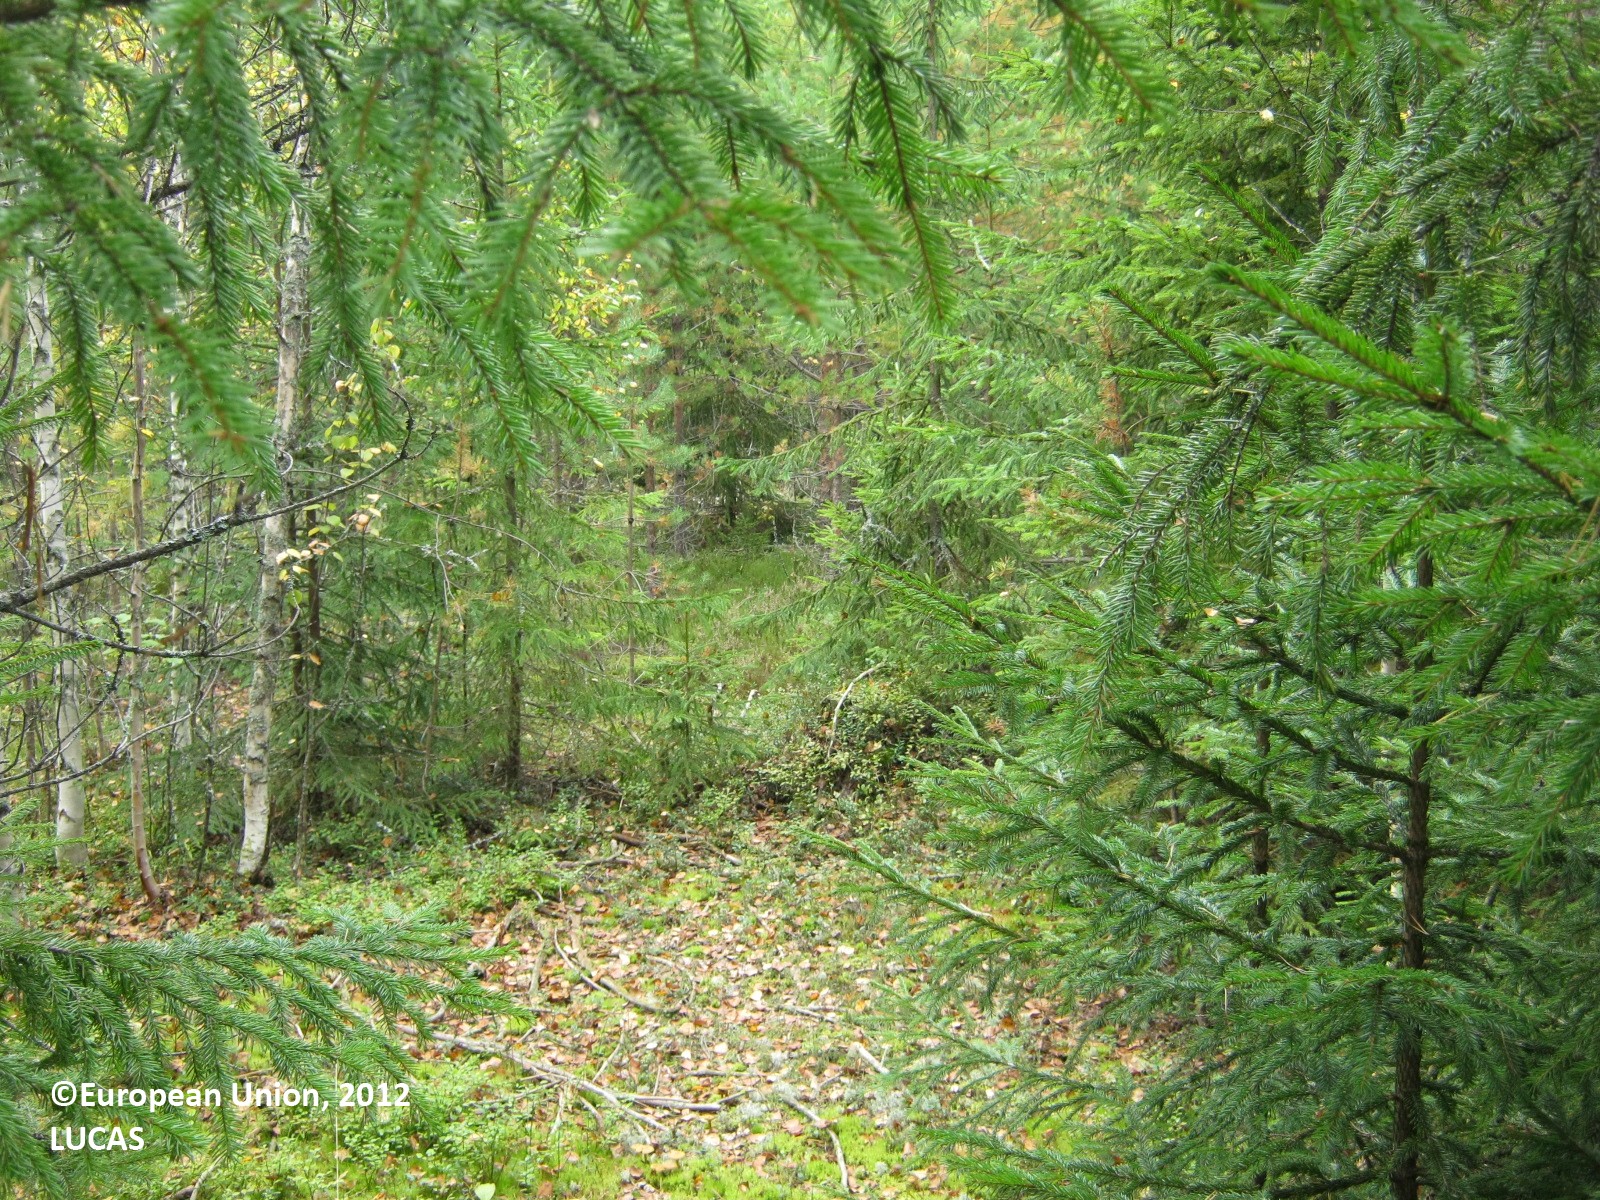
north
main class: Woodland
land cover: Pine dominated mixed woodland
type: boreal forest
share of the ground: > 75 %
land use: Forestry
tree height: > 5 m
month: September
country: FI
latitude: 60.5810
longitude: 27.5818
